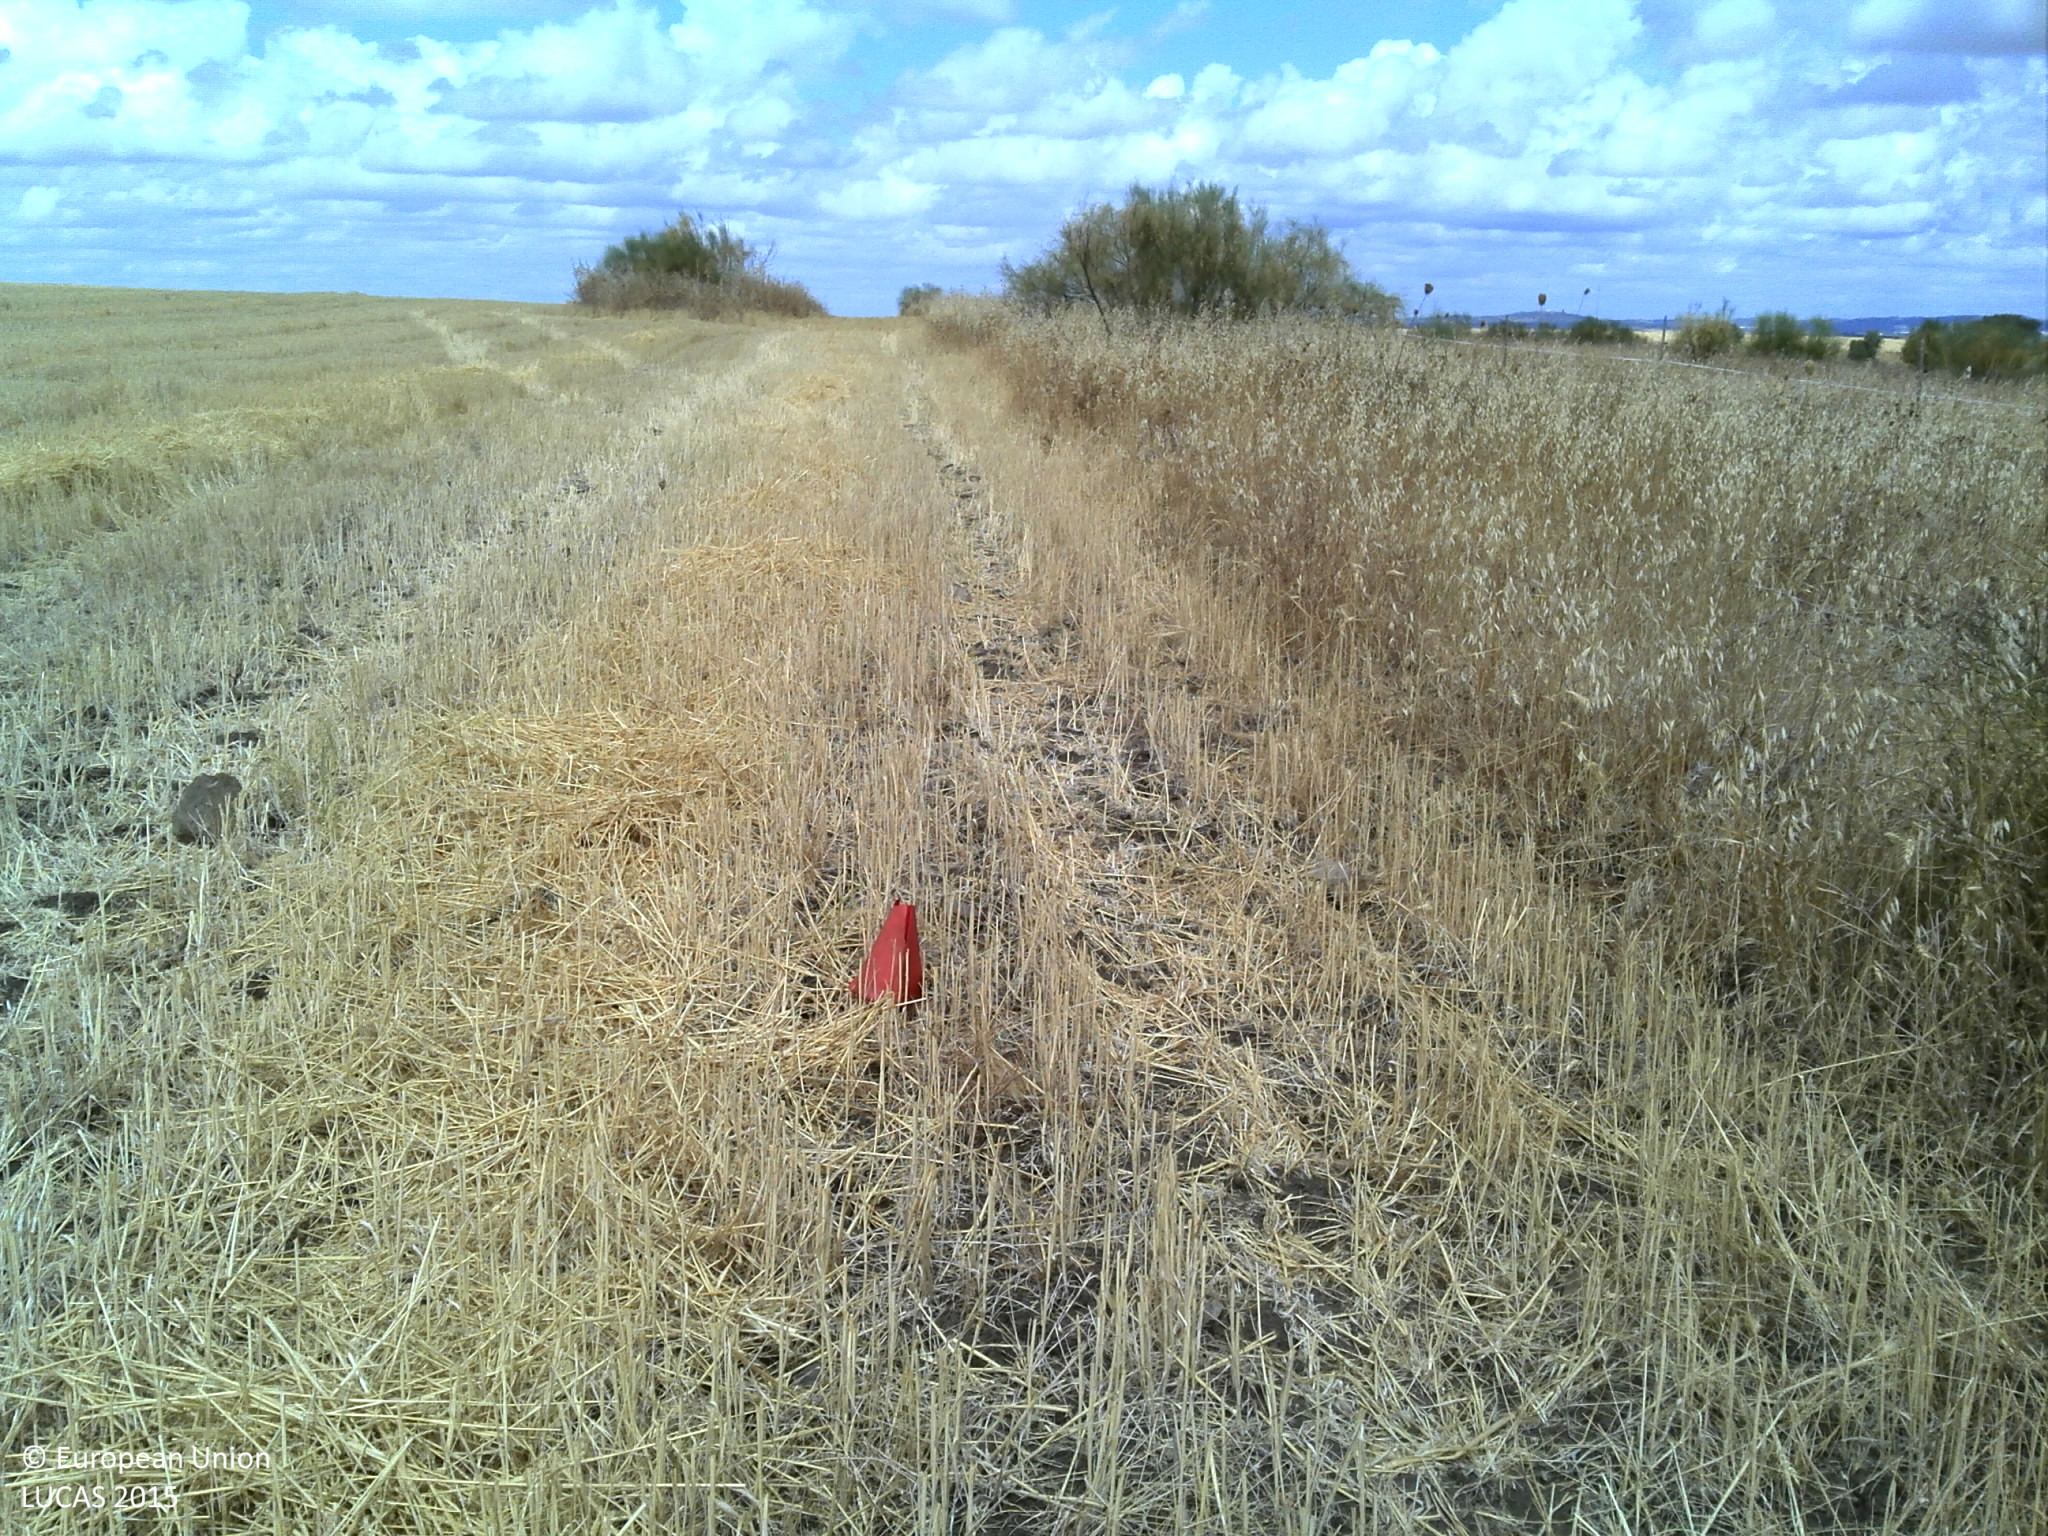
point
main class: Cropland
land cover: Common wheat
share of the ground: > 75 %
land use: Agriculture (excluding fallow land and kitchen gardens)
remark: Harvested field
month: July
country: PT
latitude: 38.1049
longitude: -7.7140
